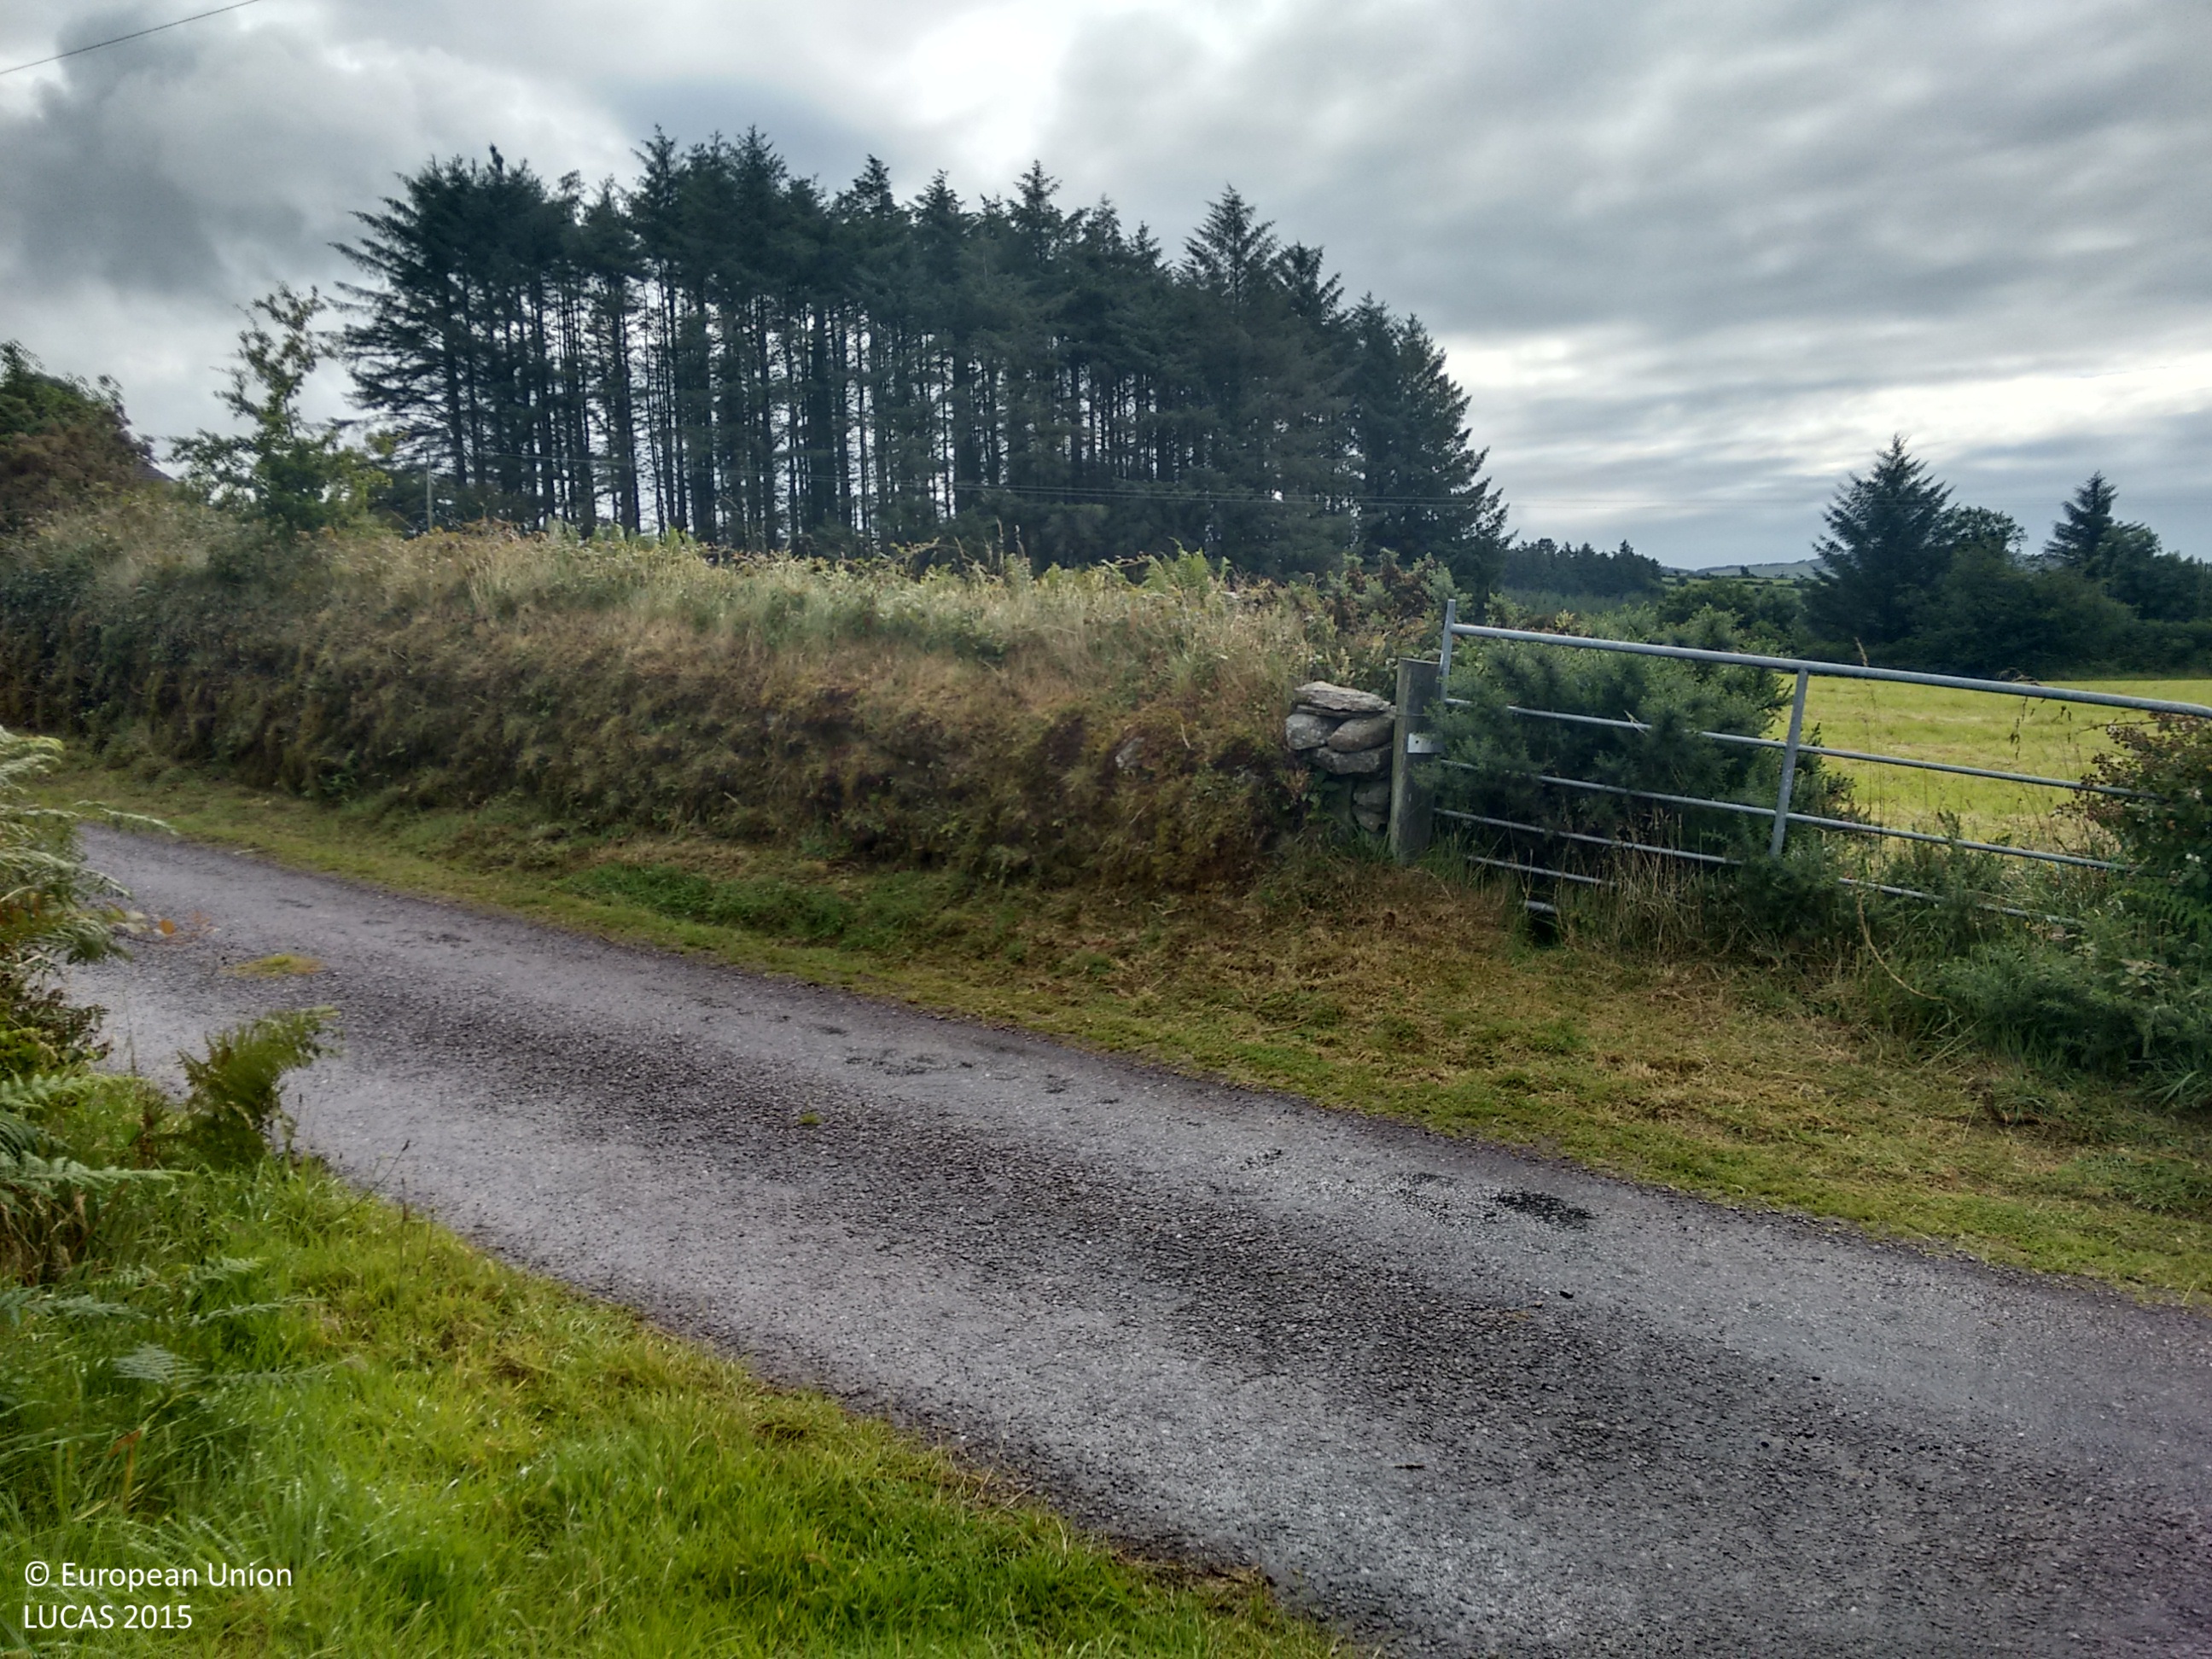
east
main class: Grassland
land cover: Grassland without tree/shrub cover
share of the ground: > 75 %
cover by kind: herbaceous plants 95 %, shrubs 5 %
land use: Agriculture (excluding fallow land and kitchen gardens)
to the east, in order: Grassland without tree/shrub cover; Shrubland with sparse tree cover; Grassland without tree/shrub cover; Fences; Abandoned hedges; Artificial constructions in urban areas; Grassland without tree/shrub cover; Fences; Shrubland with sparse tree cover
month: July
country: IE
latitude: 51.6624
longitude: -9.1728
